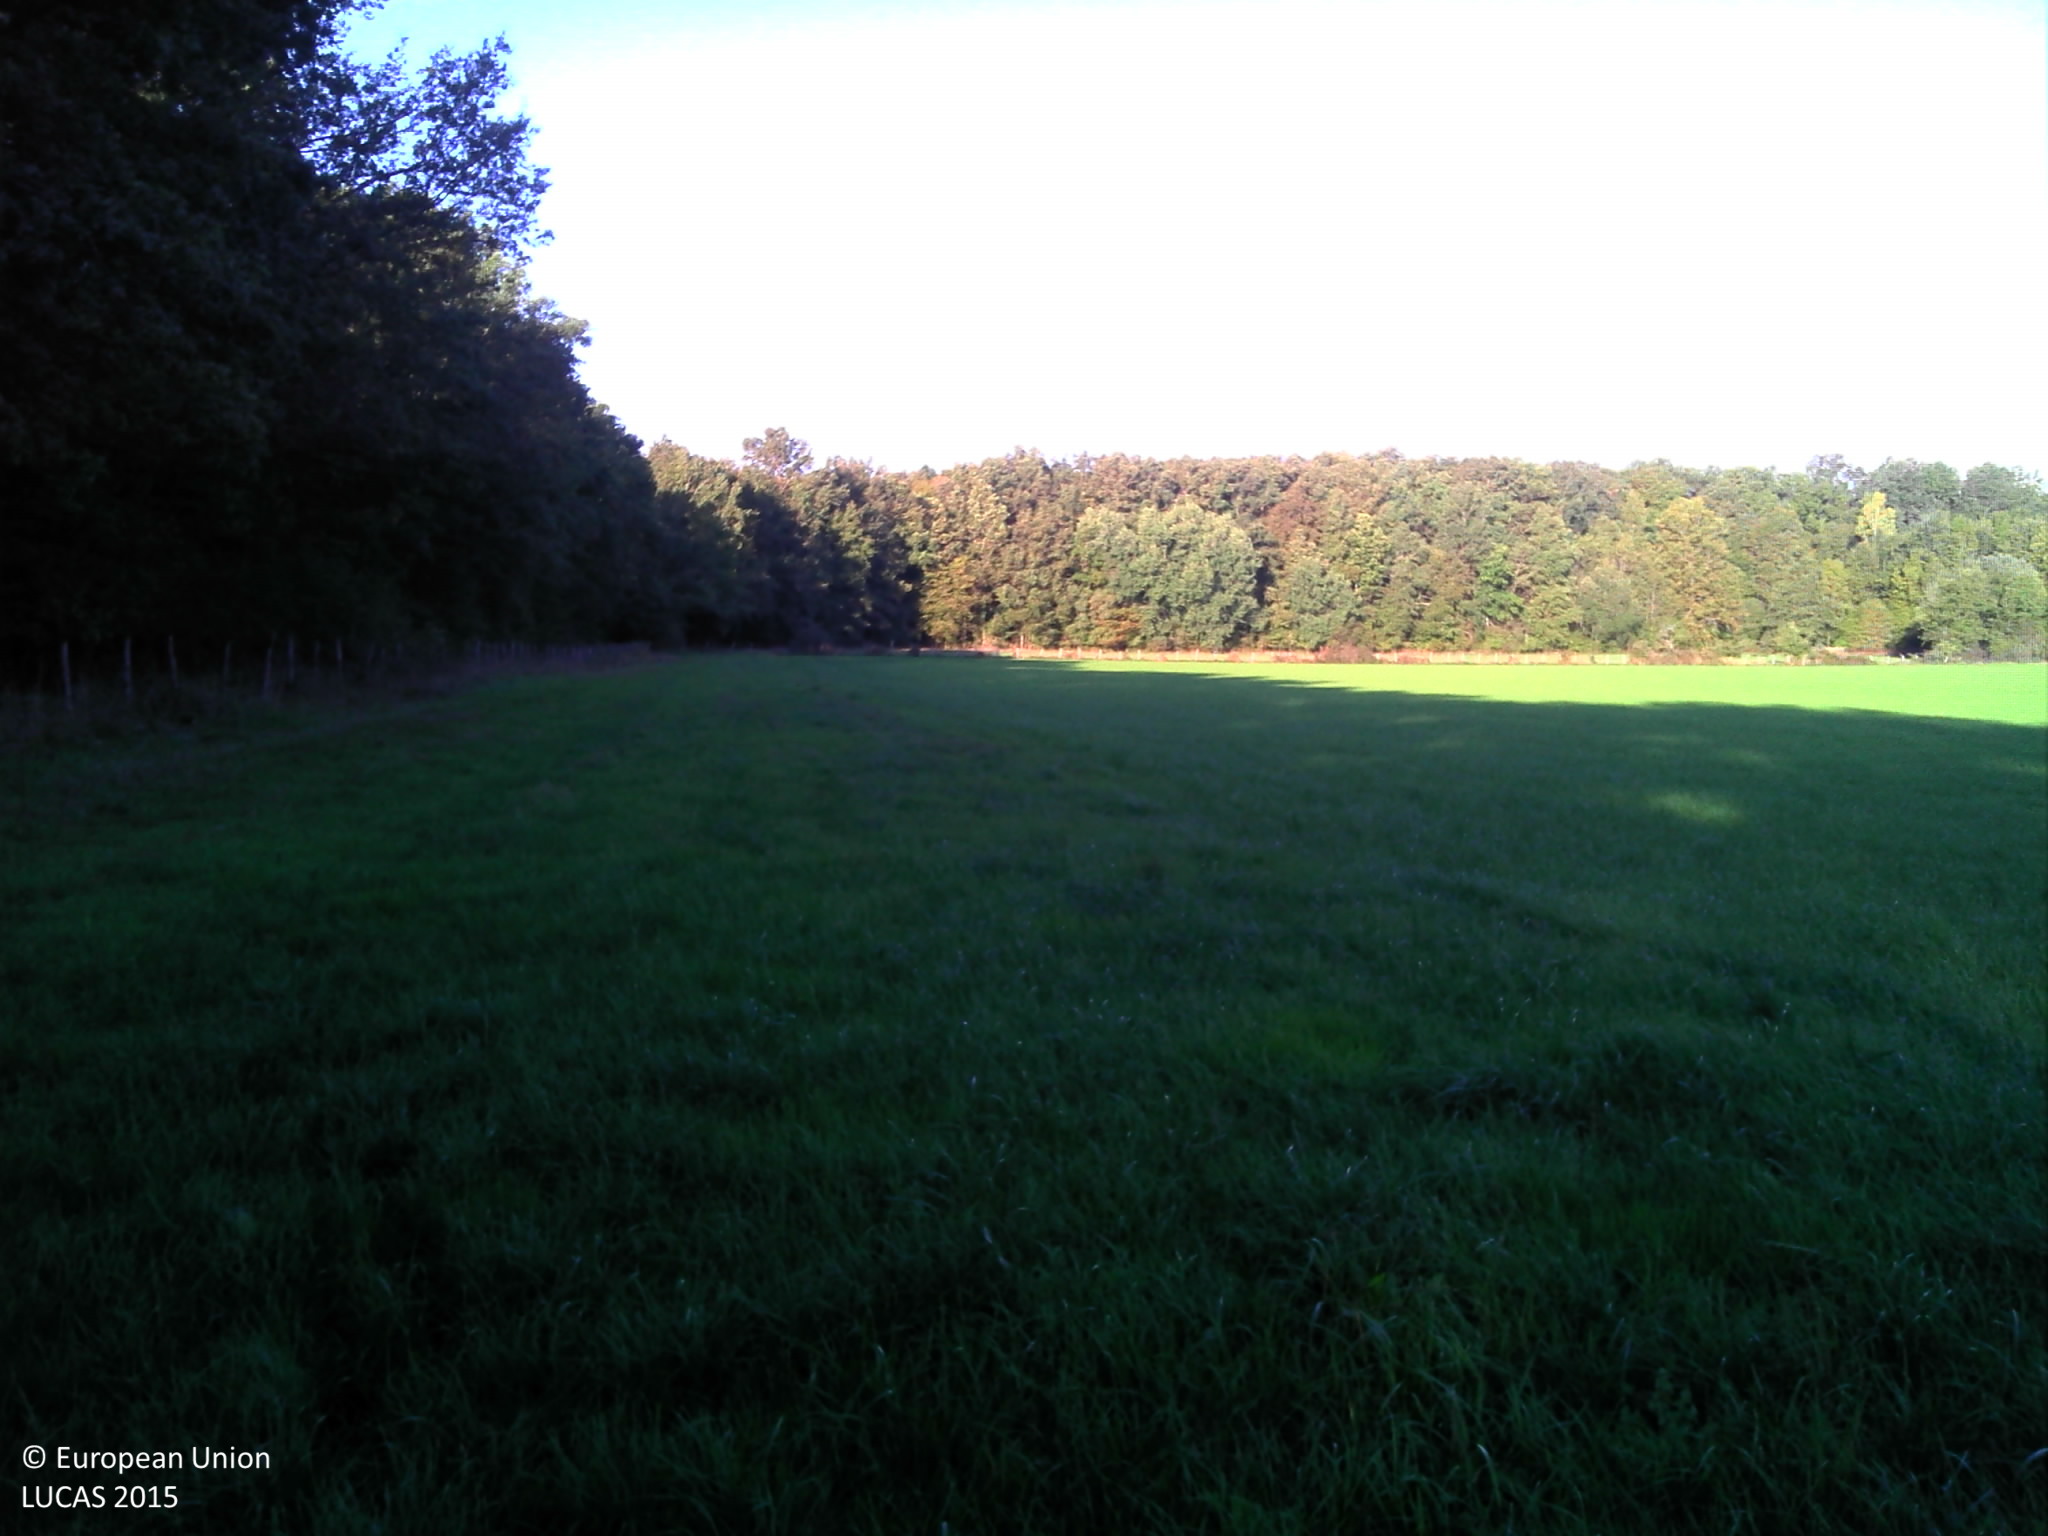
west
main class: Grassland
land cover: Grassland without tree/shrub cover
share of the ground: > 75 %
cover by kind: herbaceous plants 100 %
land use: Agriculture (excluding fallow land and kitchen gardens)
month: October
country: FR
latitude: 48.0362
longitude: 3.8938
